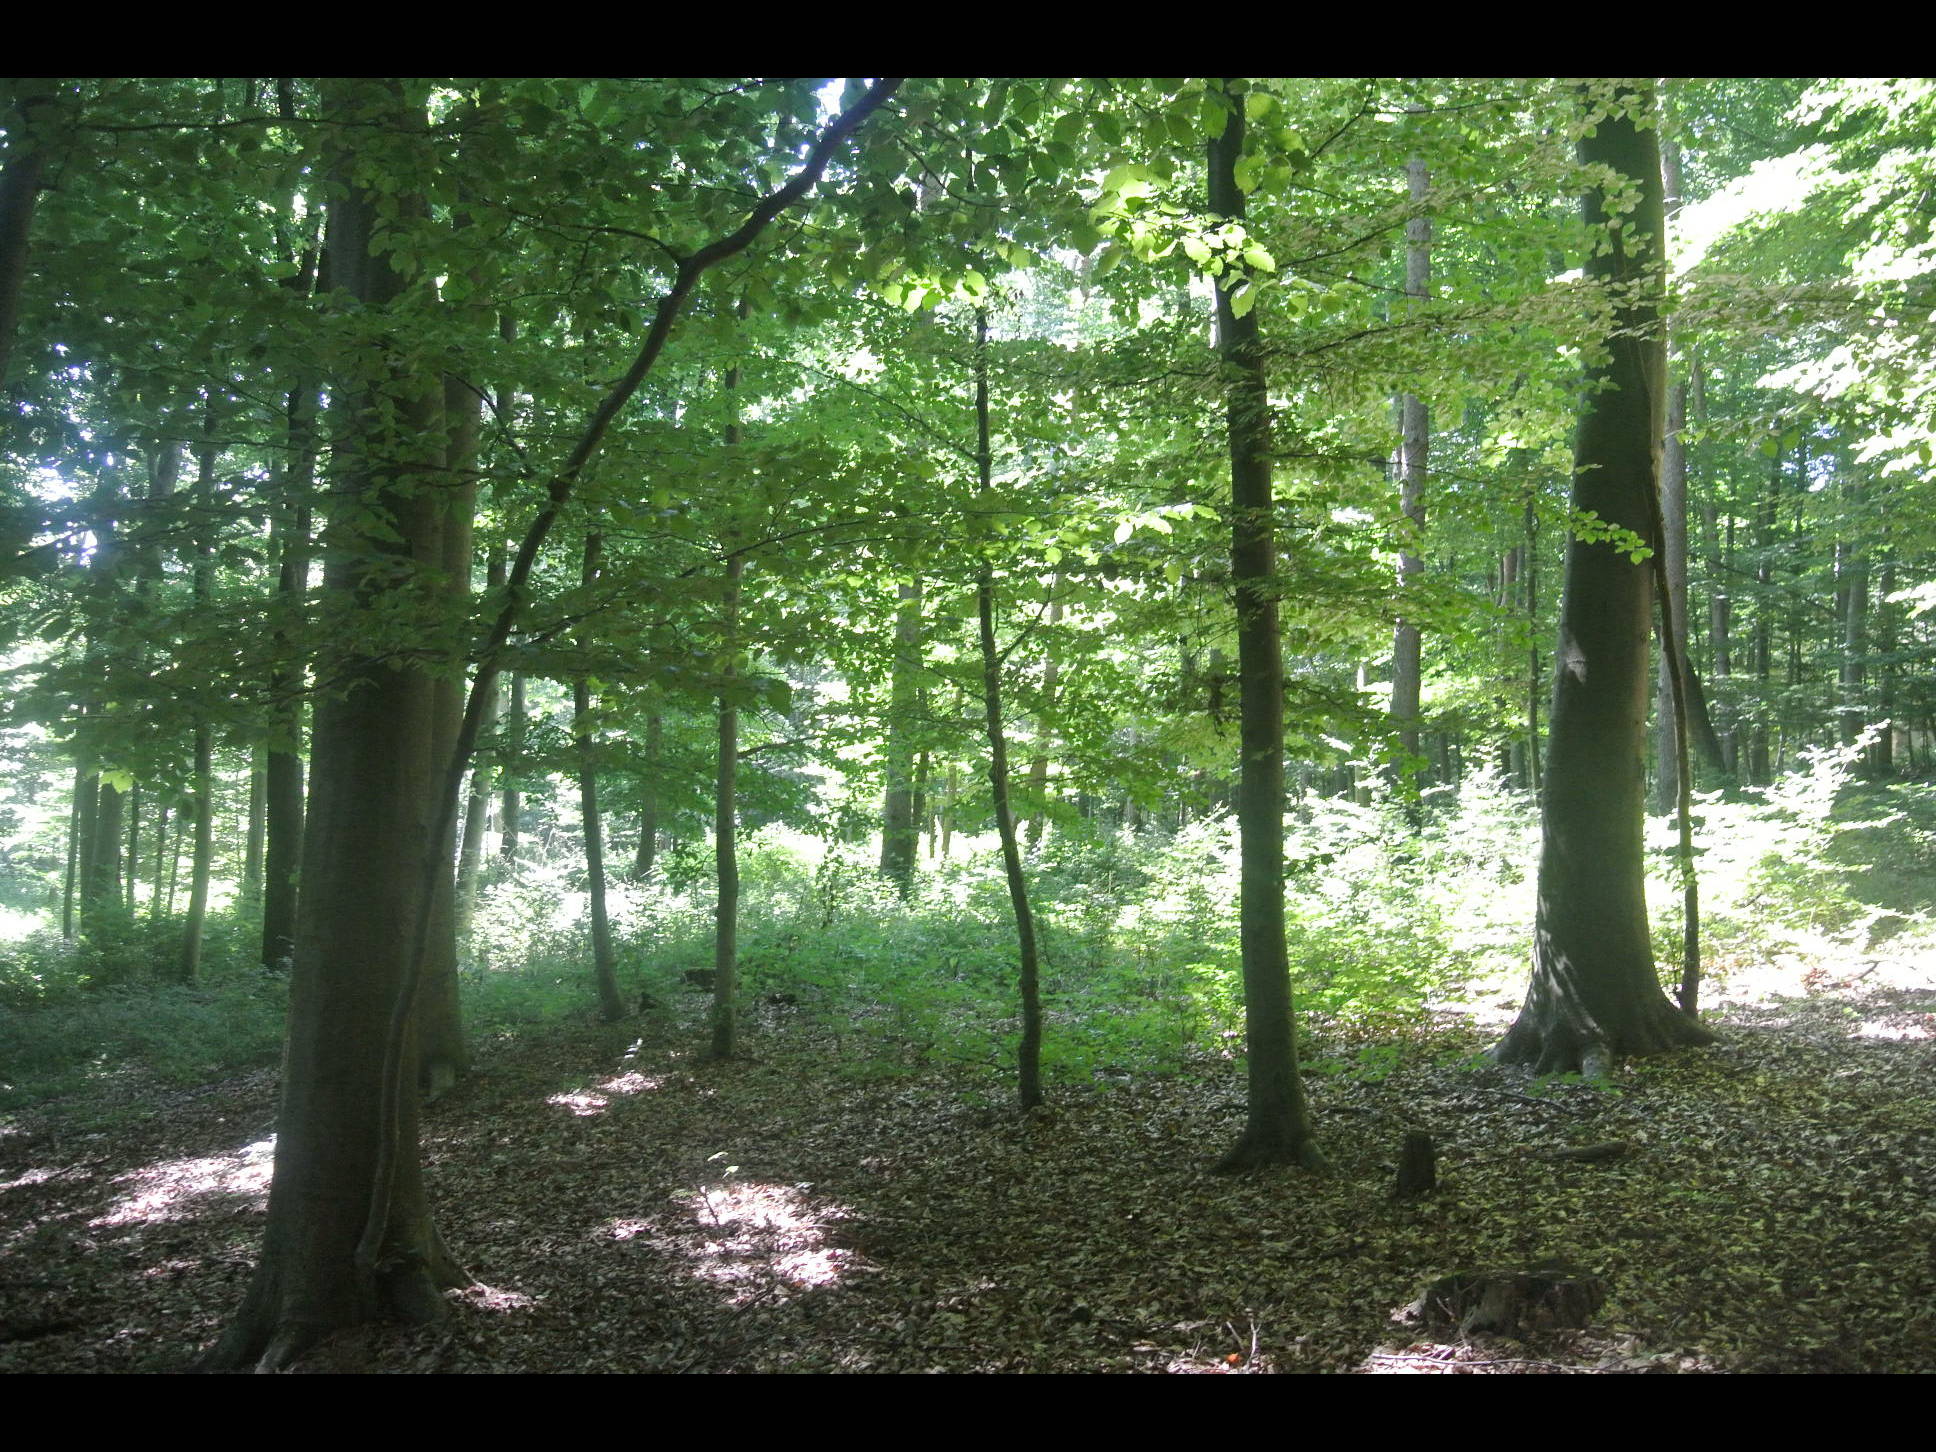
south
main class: Woodland
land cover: Broadleaved woodland
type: beech forest
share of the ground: > 75 %
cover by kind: broadleaved forest trees 100 %
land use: Forestry
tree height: > 5 m
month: July
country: AT
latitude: 47.6369
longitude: 16.4592
